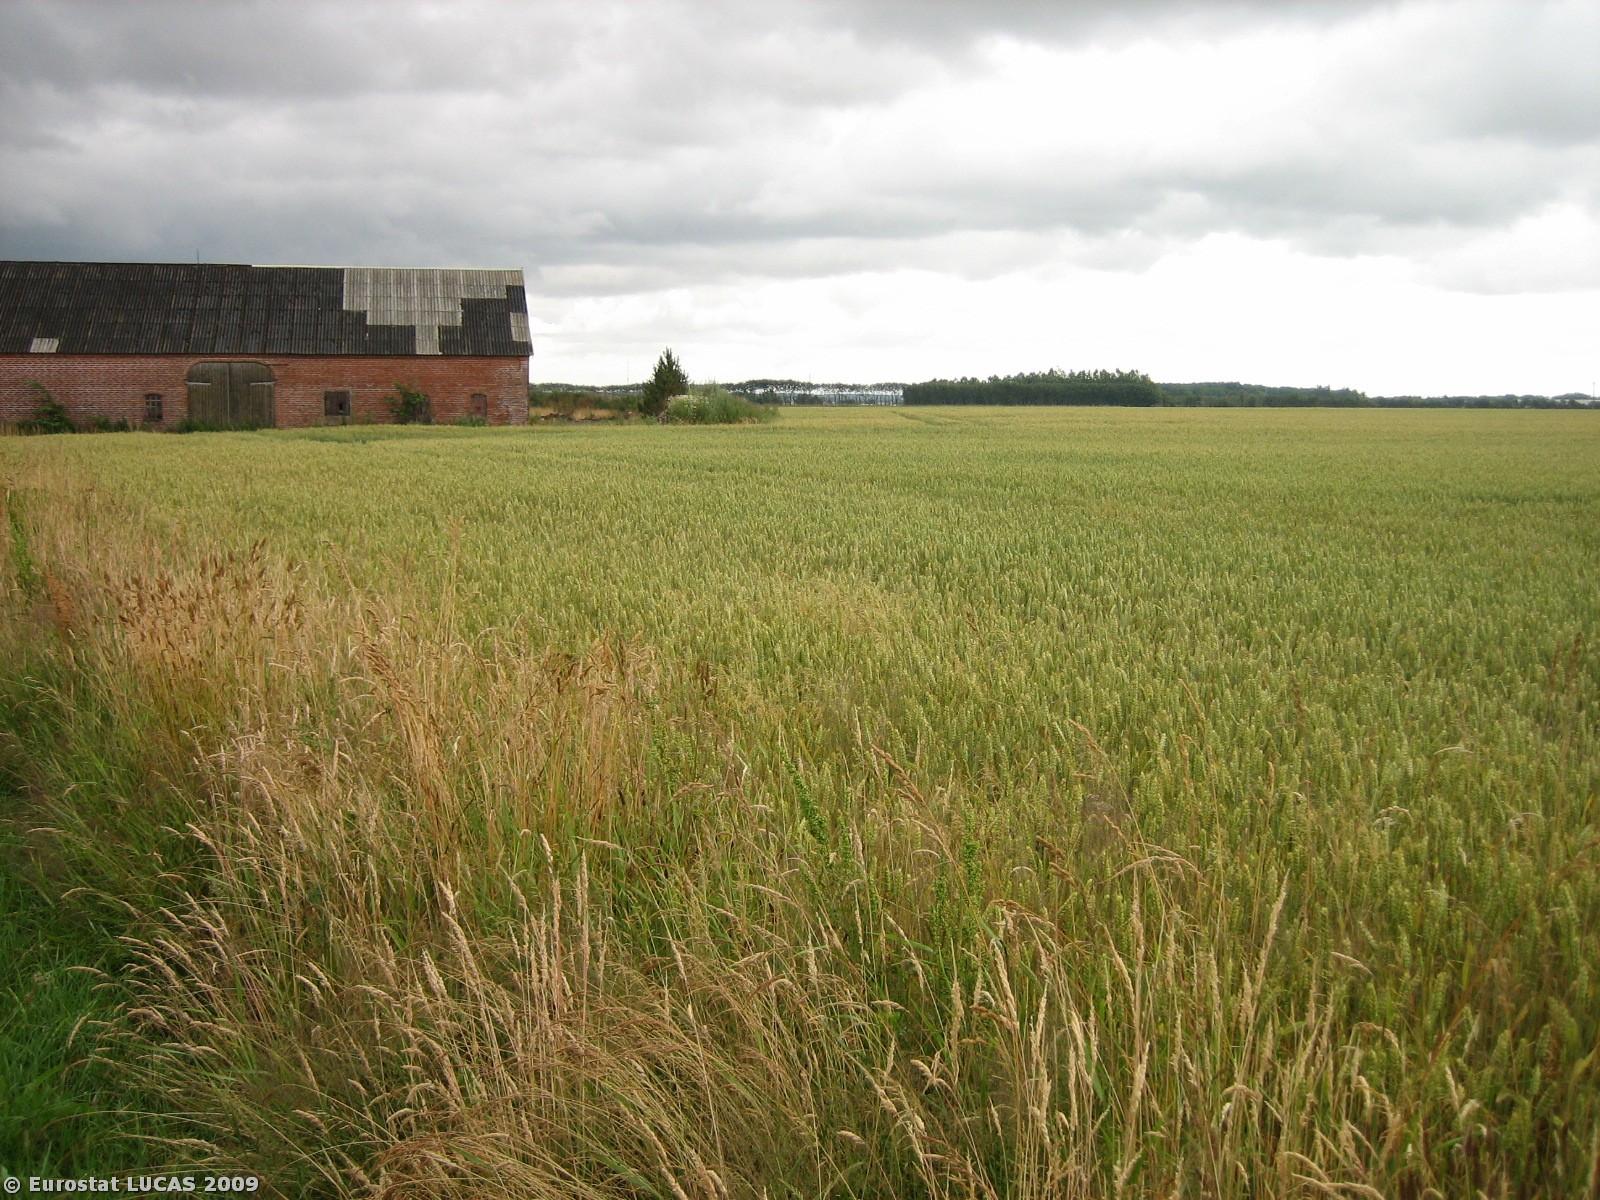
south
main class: Cropland
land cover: Common wheat
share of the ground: > 75 %
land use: Agriculture (excluding fallow land and kitchen gardens)
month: July
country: DK
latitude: 55.6380
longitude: 8.3652
